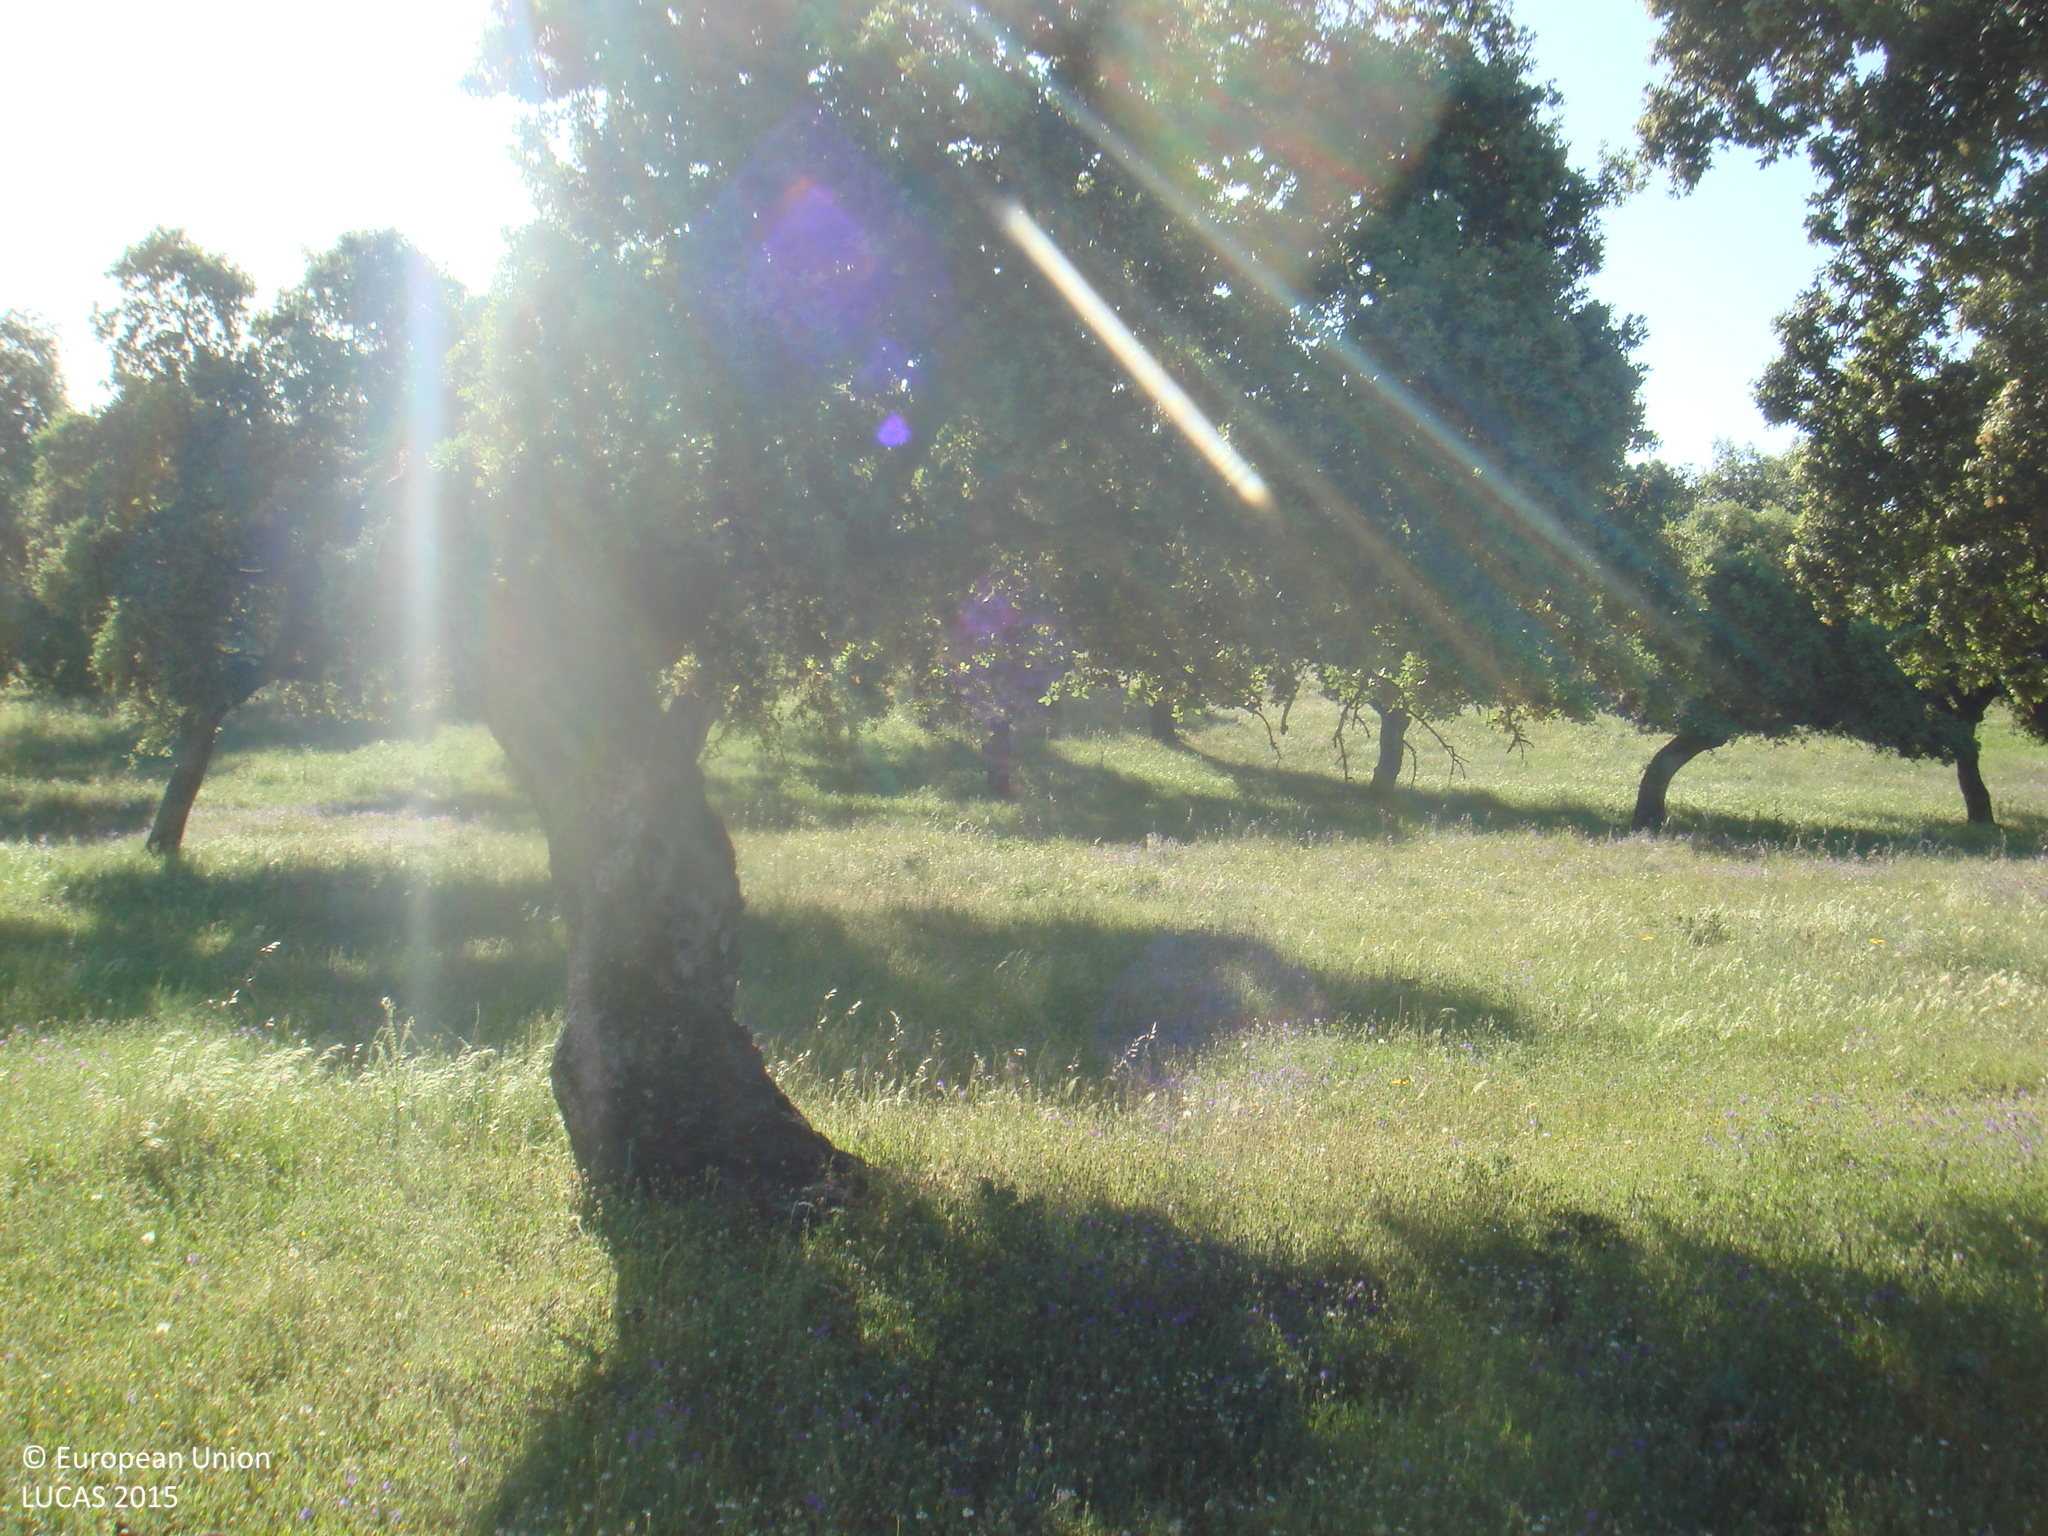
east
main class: Woodland
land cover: Broadleaved woodland
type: broadleaved evergreen forest
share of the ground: 50 - 75 %
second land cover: Spontaneously vegetated surfaces
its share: > 75 %
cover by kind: broadleaved forest trees 50 %, herbaceous plants 50 %
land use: Forestry
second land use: Agriculture (excluding fallow land and kitchen gardens)
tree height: > 5 m
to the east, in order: Broadleaved woodland; Spontaneously vegetated surfaces; Electric lines; Broadleaved woodland; Tracks; Broadleaved woodland
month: May
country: ES
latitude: 38.3203
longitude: -4.7417
